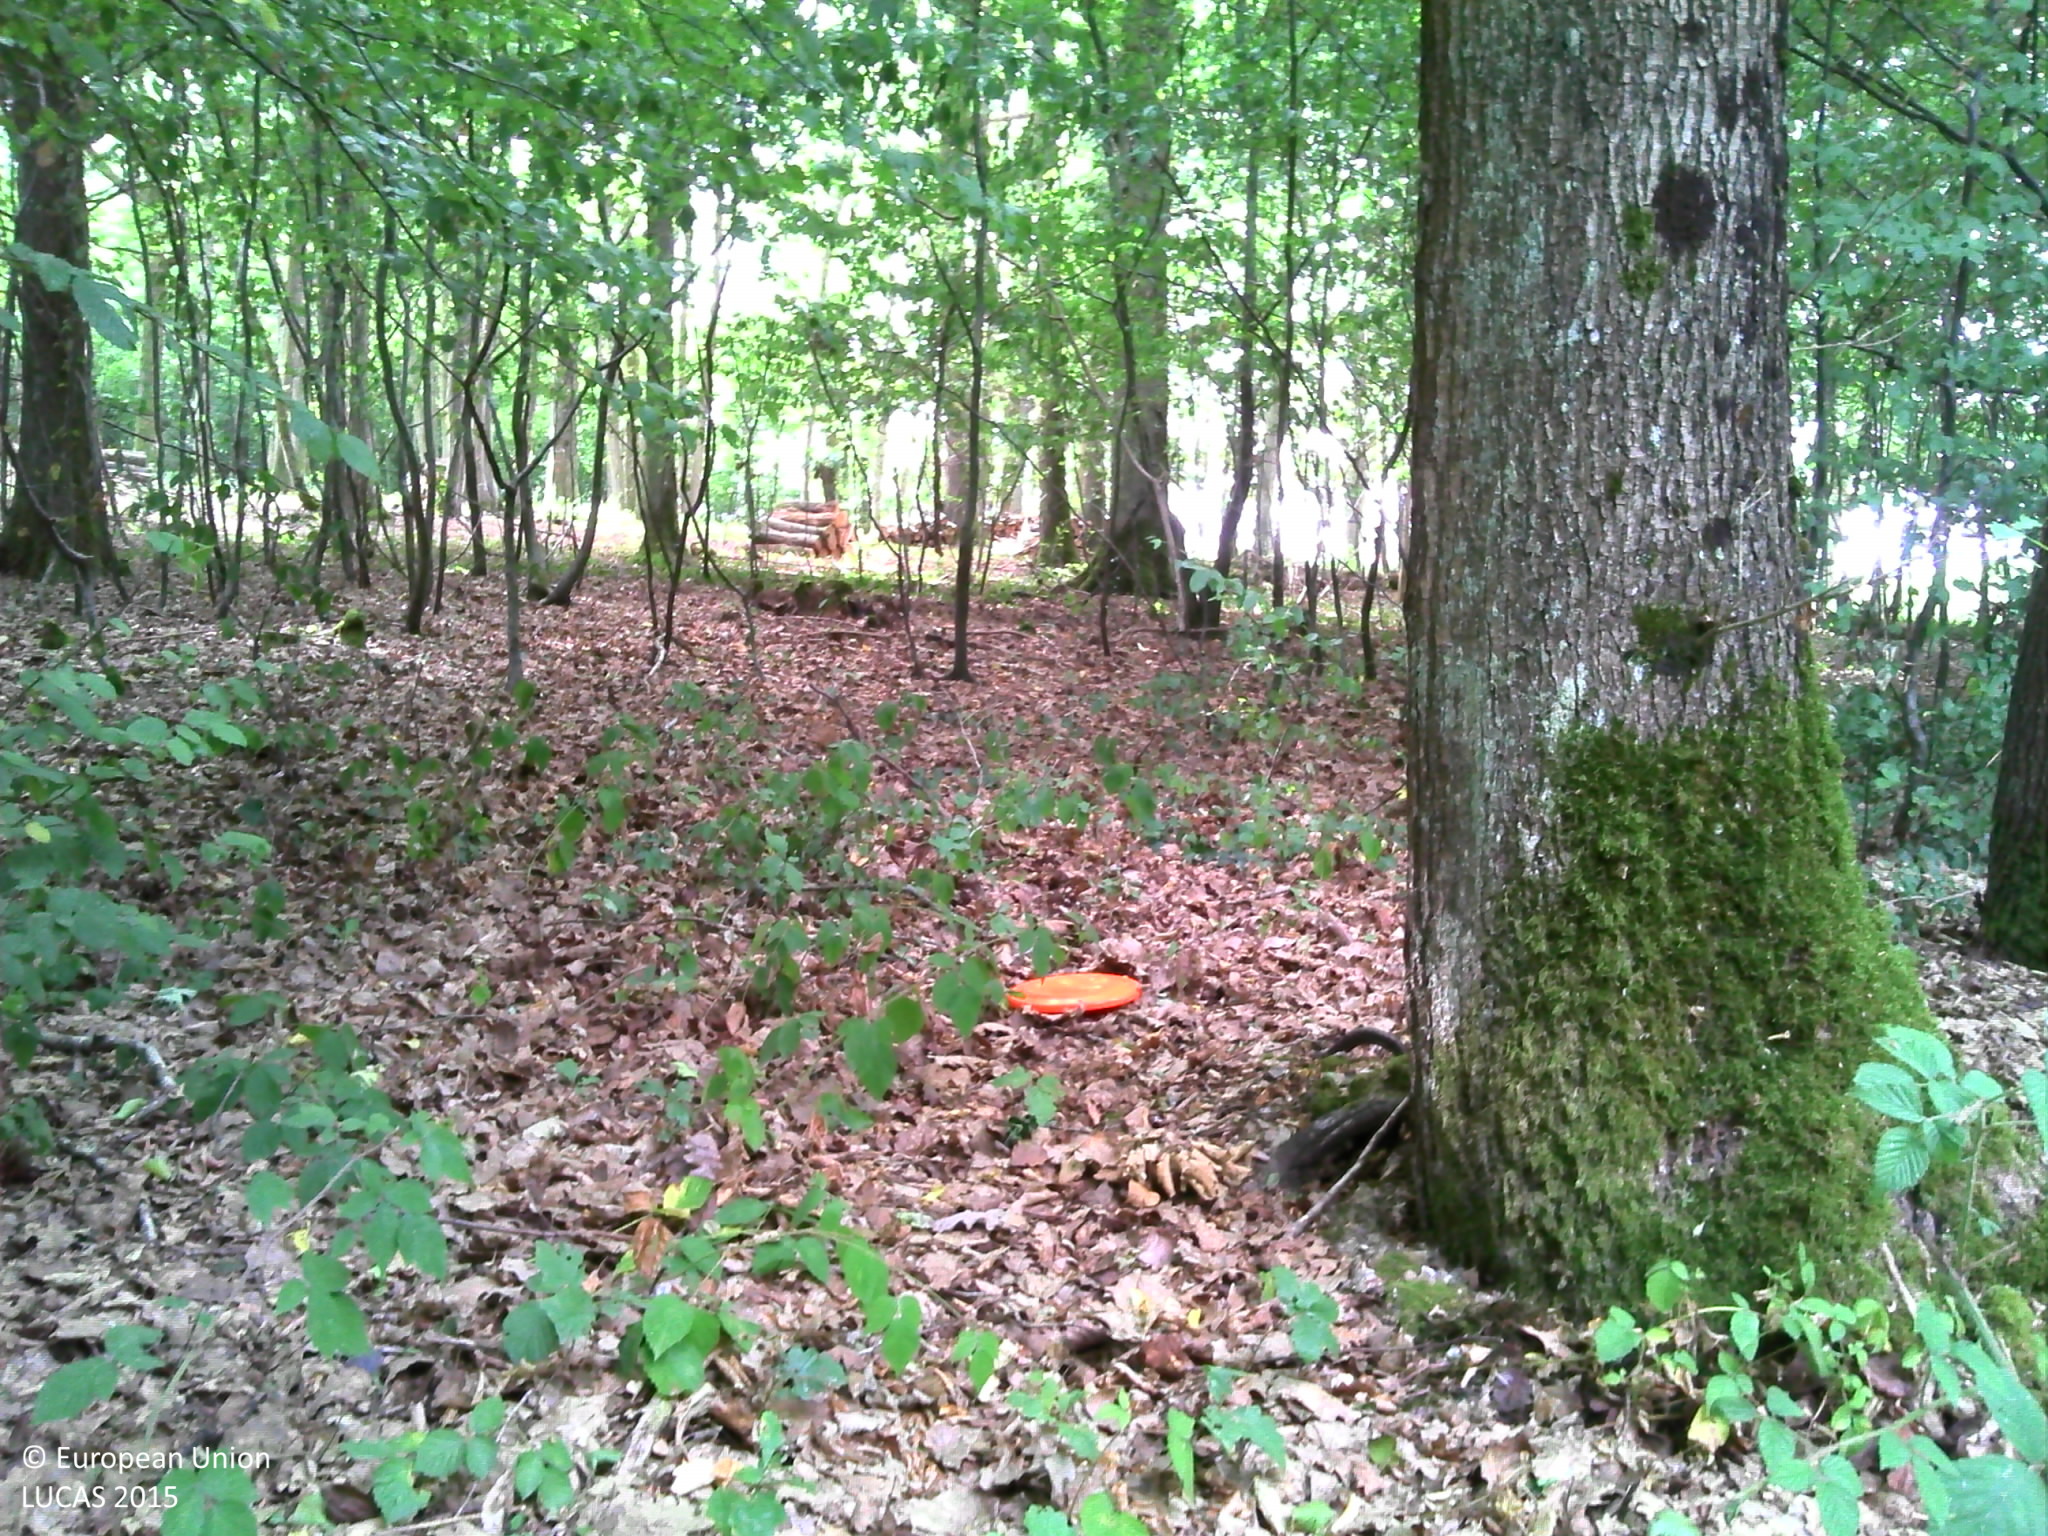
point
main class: Woodland
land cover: Broadleaved woodland
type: mesophytic deciduous forest
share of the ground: > 75 %
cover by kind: broadleaved forest trees 90 %, herbaceous plants 5 %, lichens and mosses 5 %
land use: Forestry
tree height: > 5 m
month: July
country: FR
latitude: 47.9350
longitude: 3.0998
